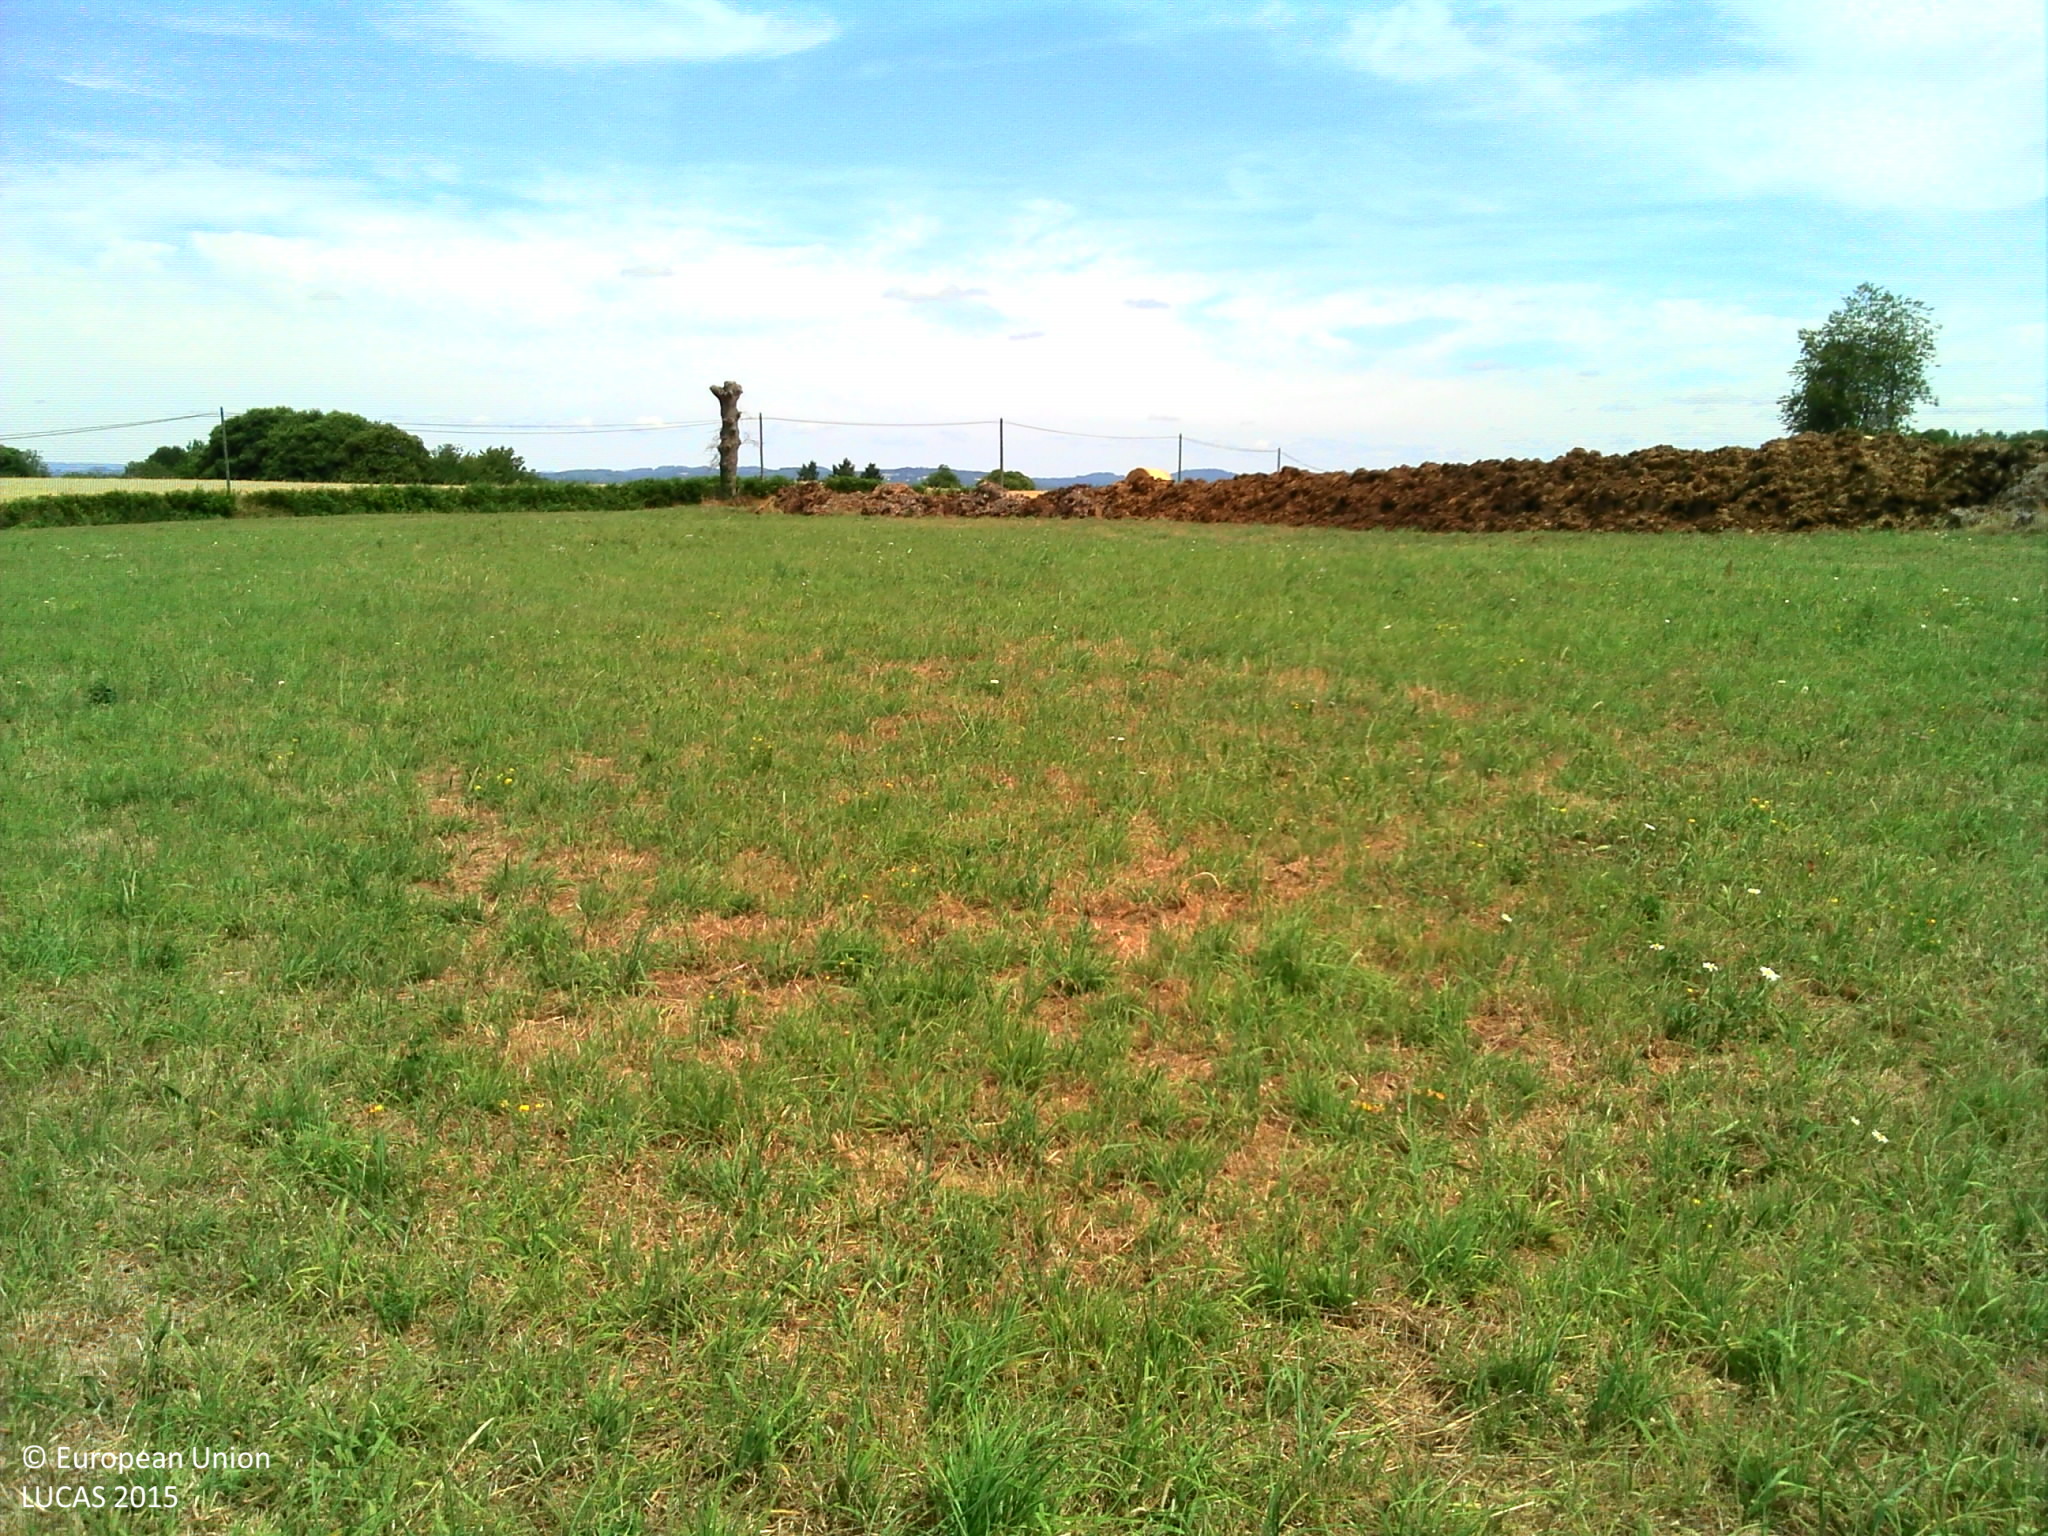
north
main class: Cropland
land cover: Temporary grasslands
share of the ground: > 75 %
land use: Agriculture (excluding fallow land and kitchen gardens)
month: July
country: FR
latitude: 45.7328
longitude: 1.6276
